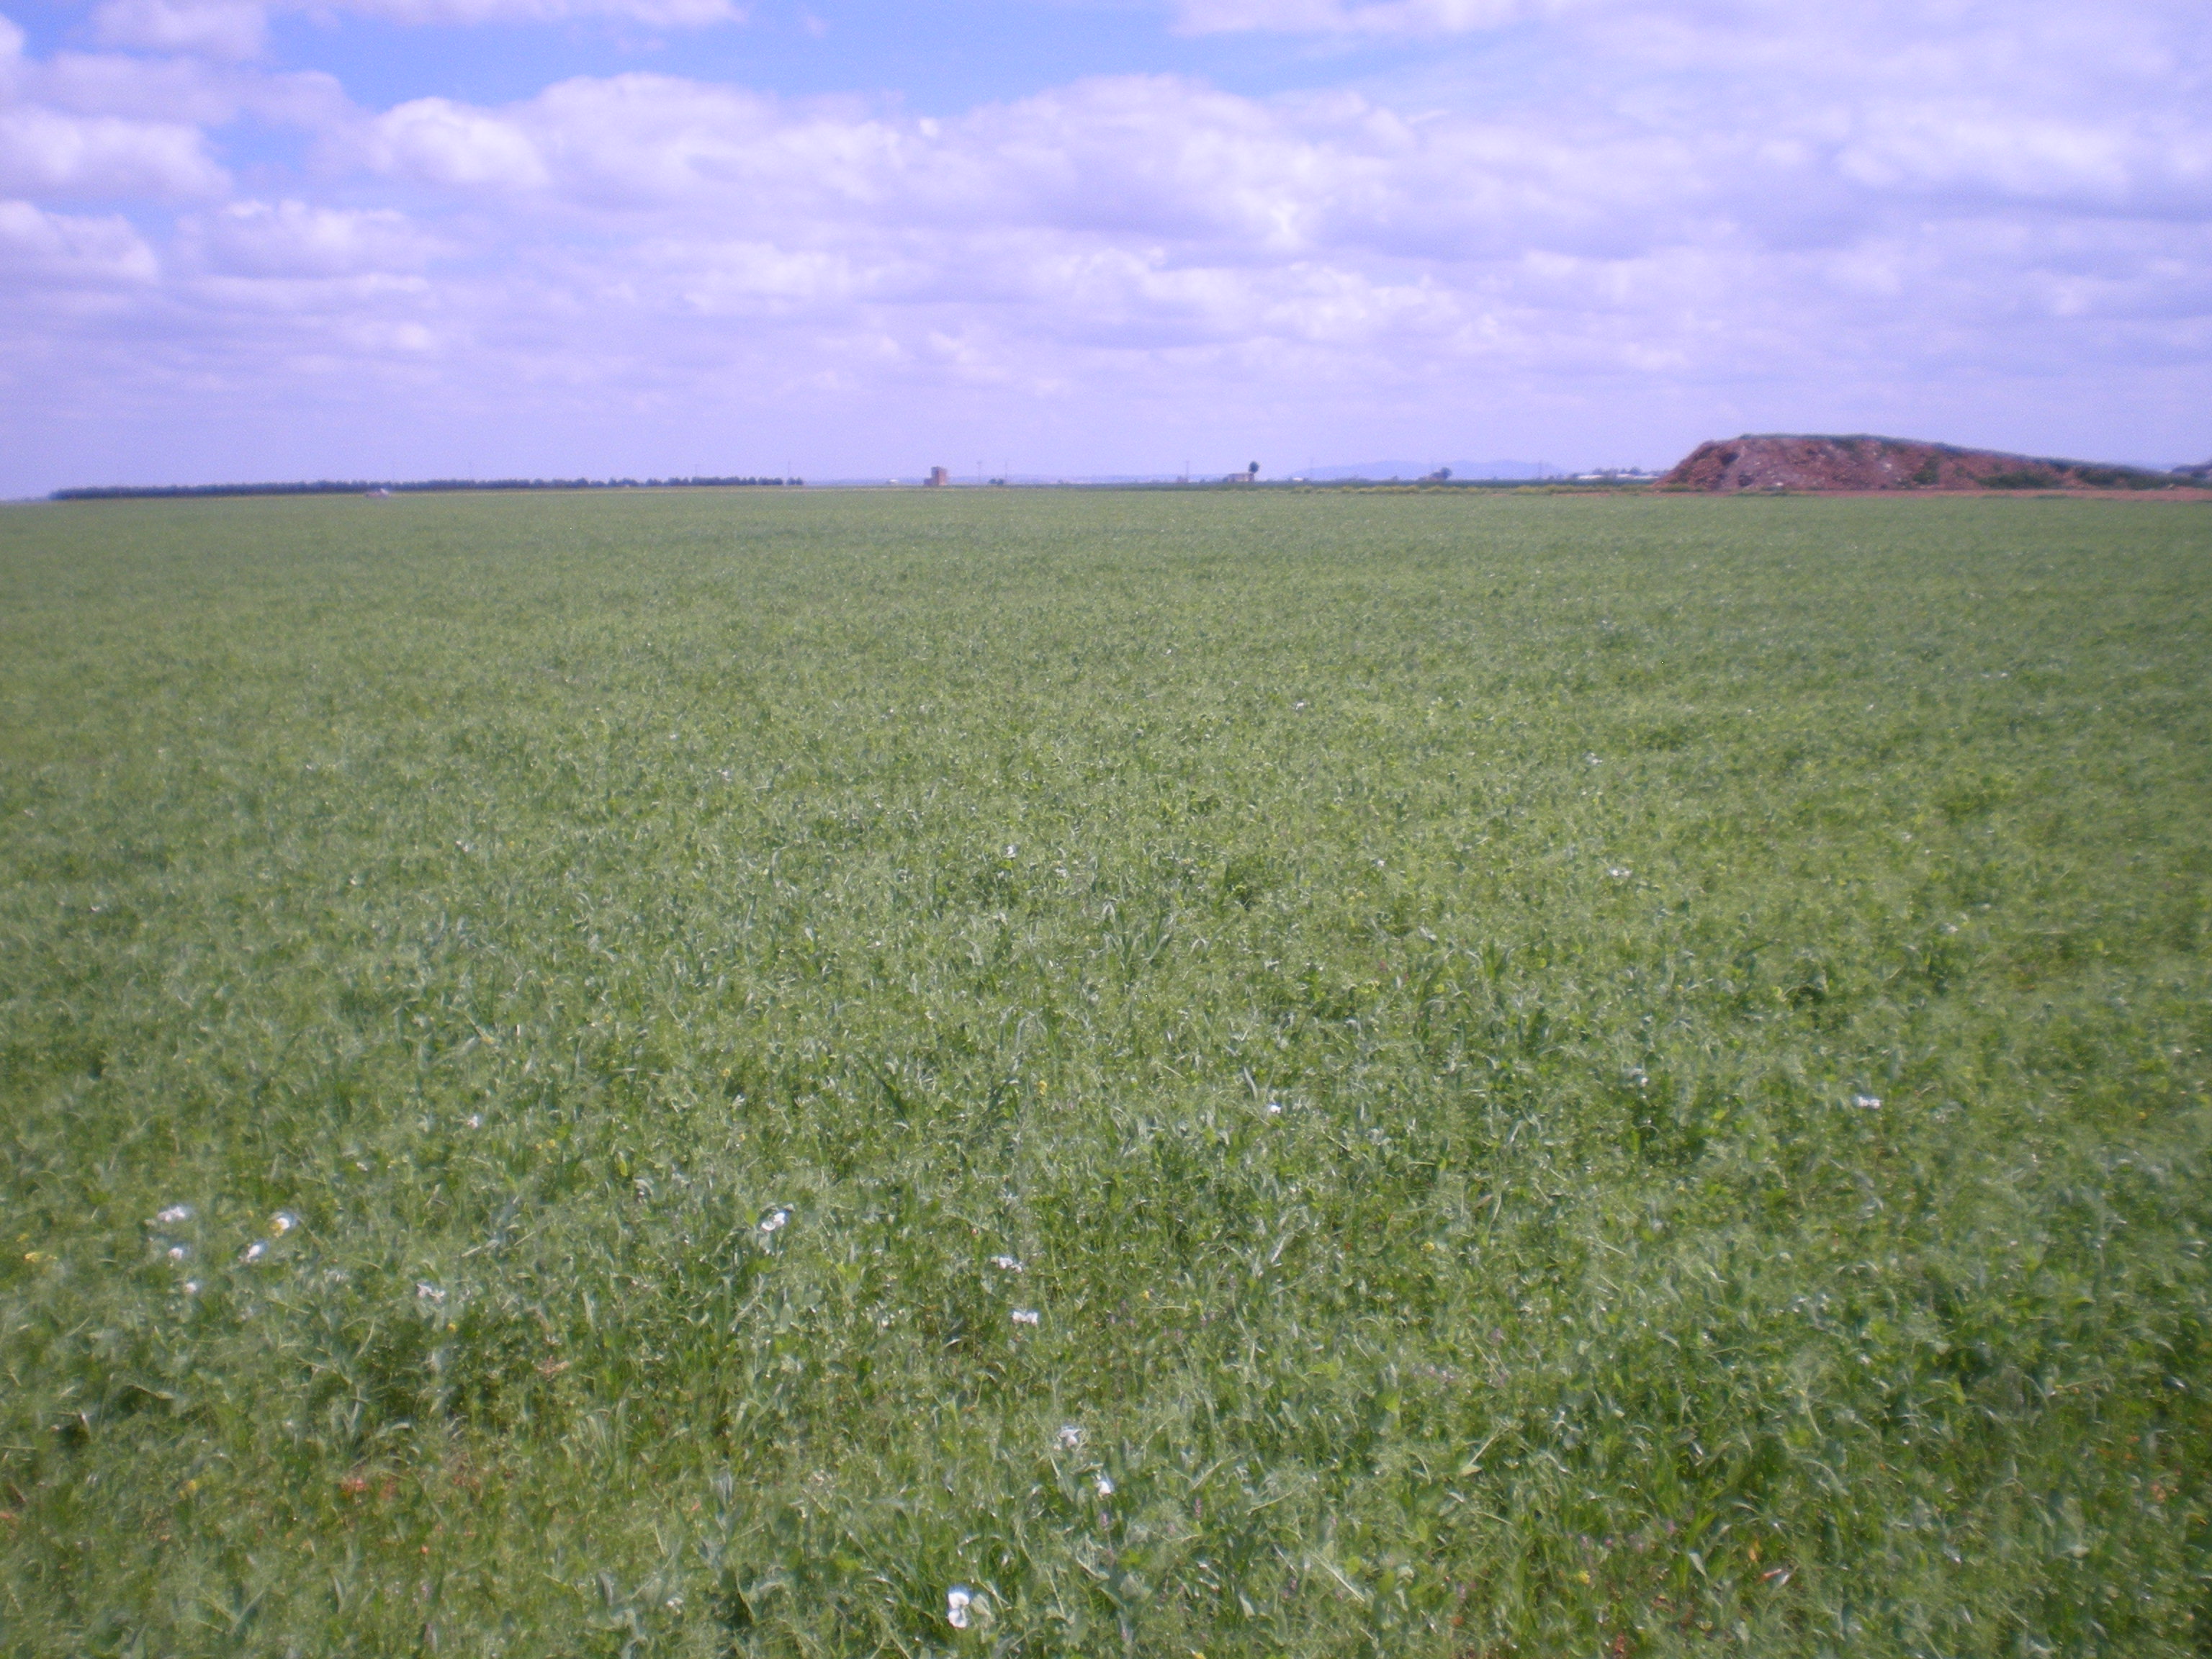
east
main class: Cropland
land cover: Other fresh vegetables
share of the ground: 50 - 75 %
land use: Agriculture (excluding fallow land and kitchen gardens)
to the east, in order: Other fresh vegetables
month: April
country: ES
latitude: 38.9946
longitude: -3.5361
